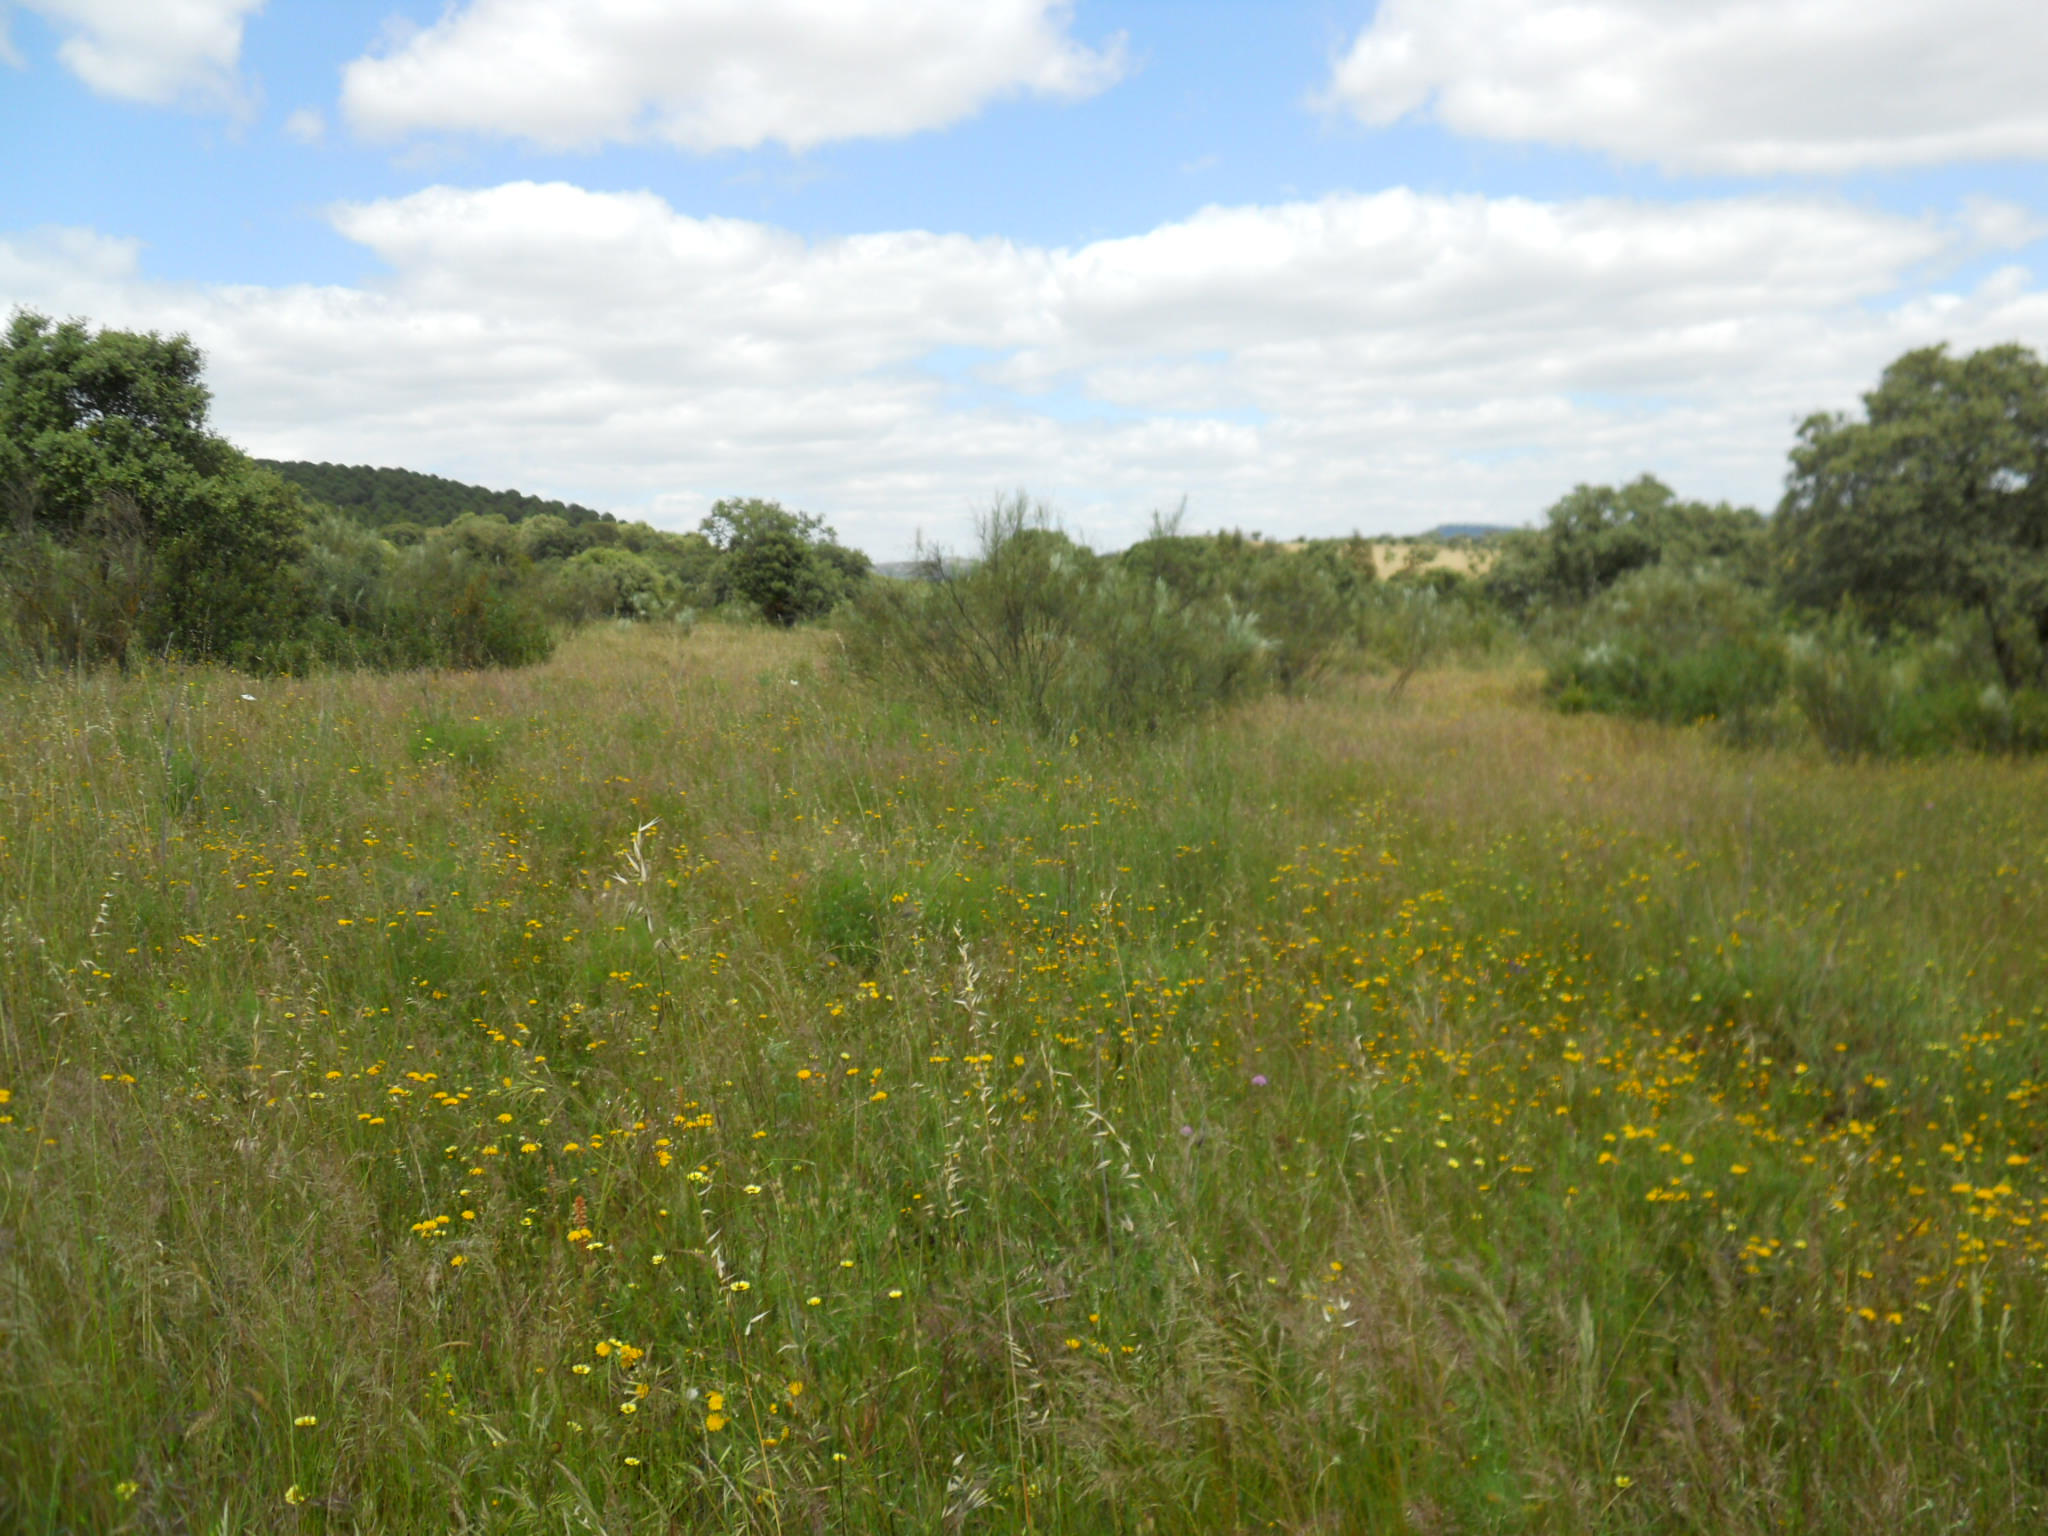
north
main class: Grassland
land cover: Grassland with sparse tree/shrub cover
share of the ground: > 75 %
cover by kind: herbaceous plants 85 %, shrubs 10 %, broadleaved forest trees 5 %
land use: Agriculture (excluding fallow land and kitchen gardens)
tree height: > 5 m
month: May
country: ES
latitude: 39.1536
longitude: -7.0287
